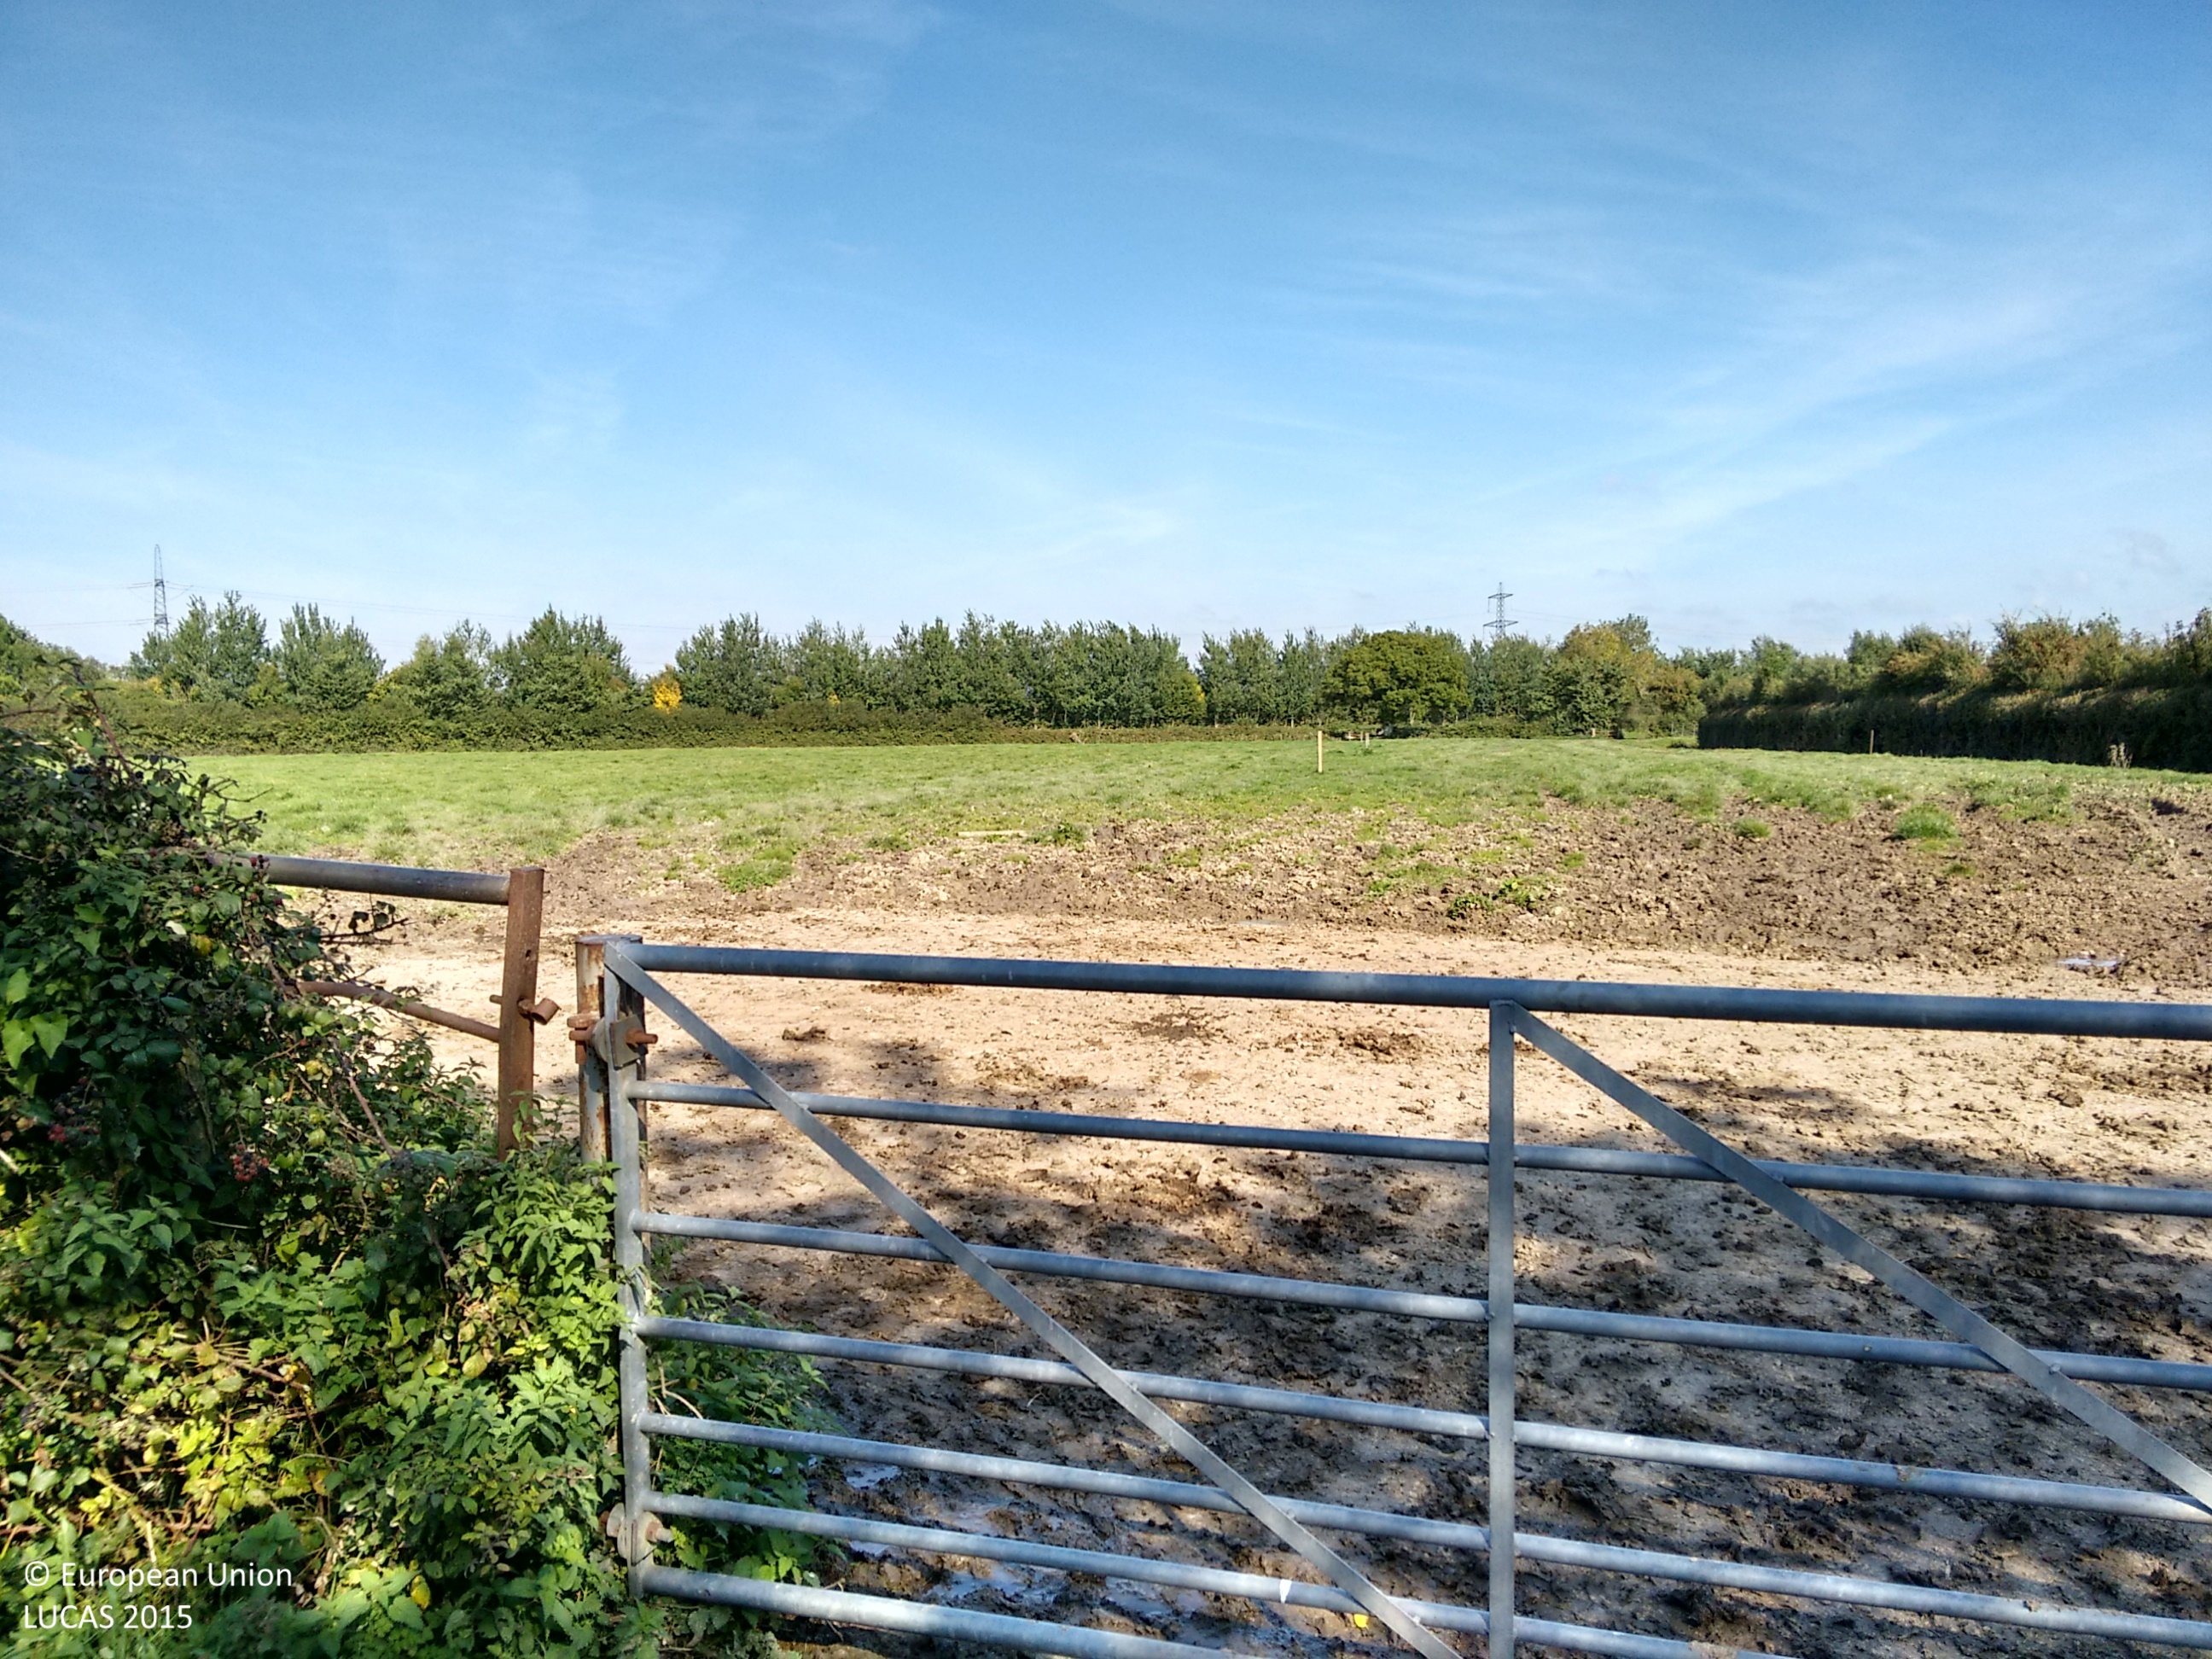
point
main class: Grassland
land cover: Grassland without tree/shrub cover
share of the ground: > 75 %
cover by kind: herbaceous plants 100 %
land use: Agriculture (excluding fallow land and kitchen gardens)
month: September
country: GB
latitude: 51.5745
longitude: -2.6072
